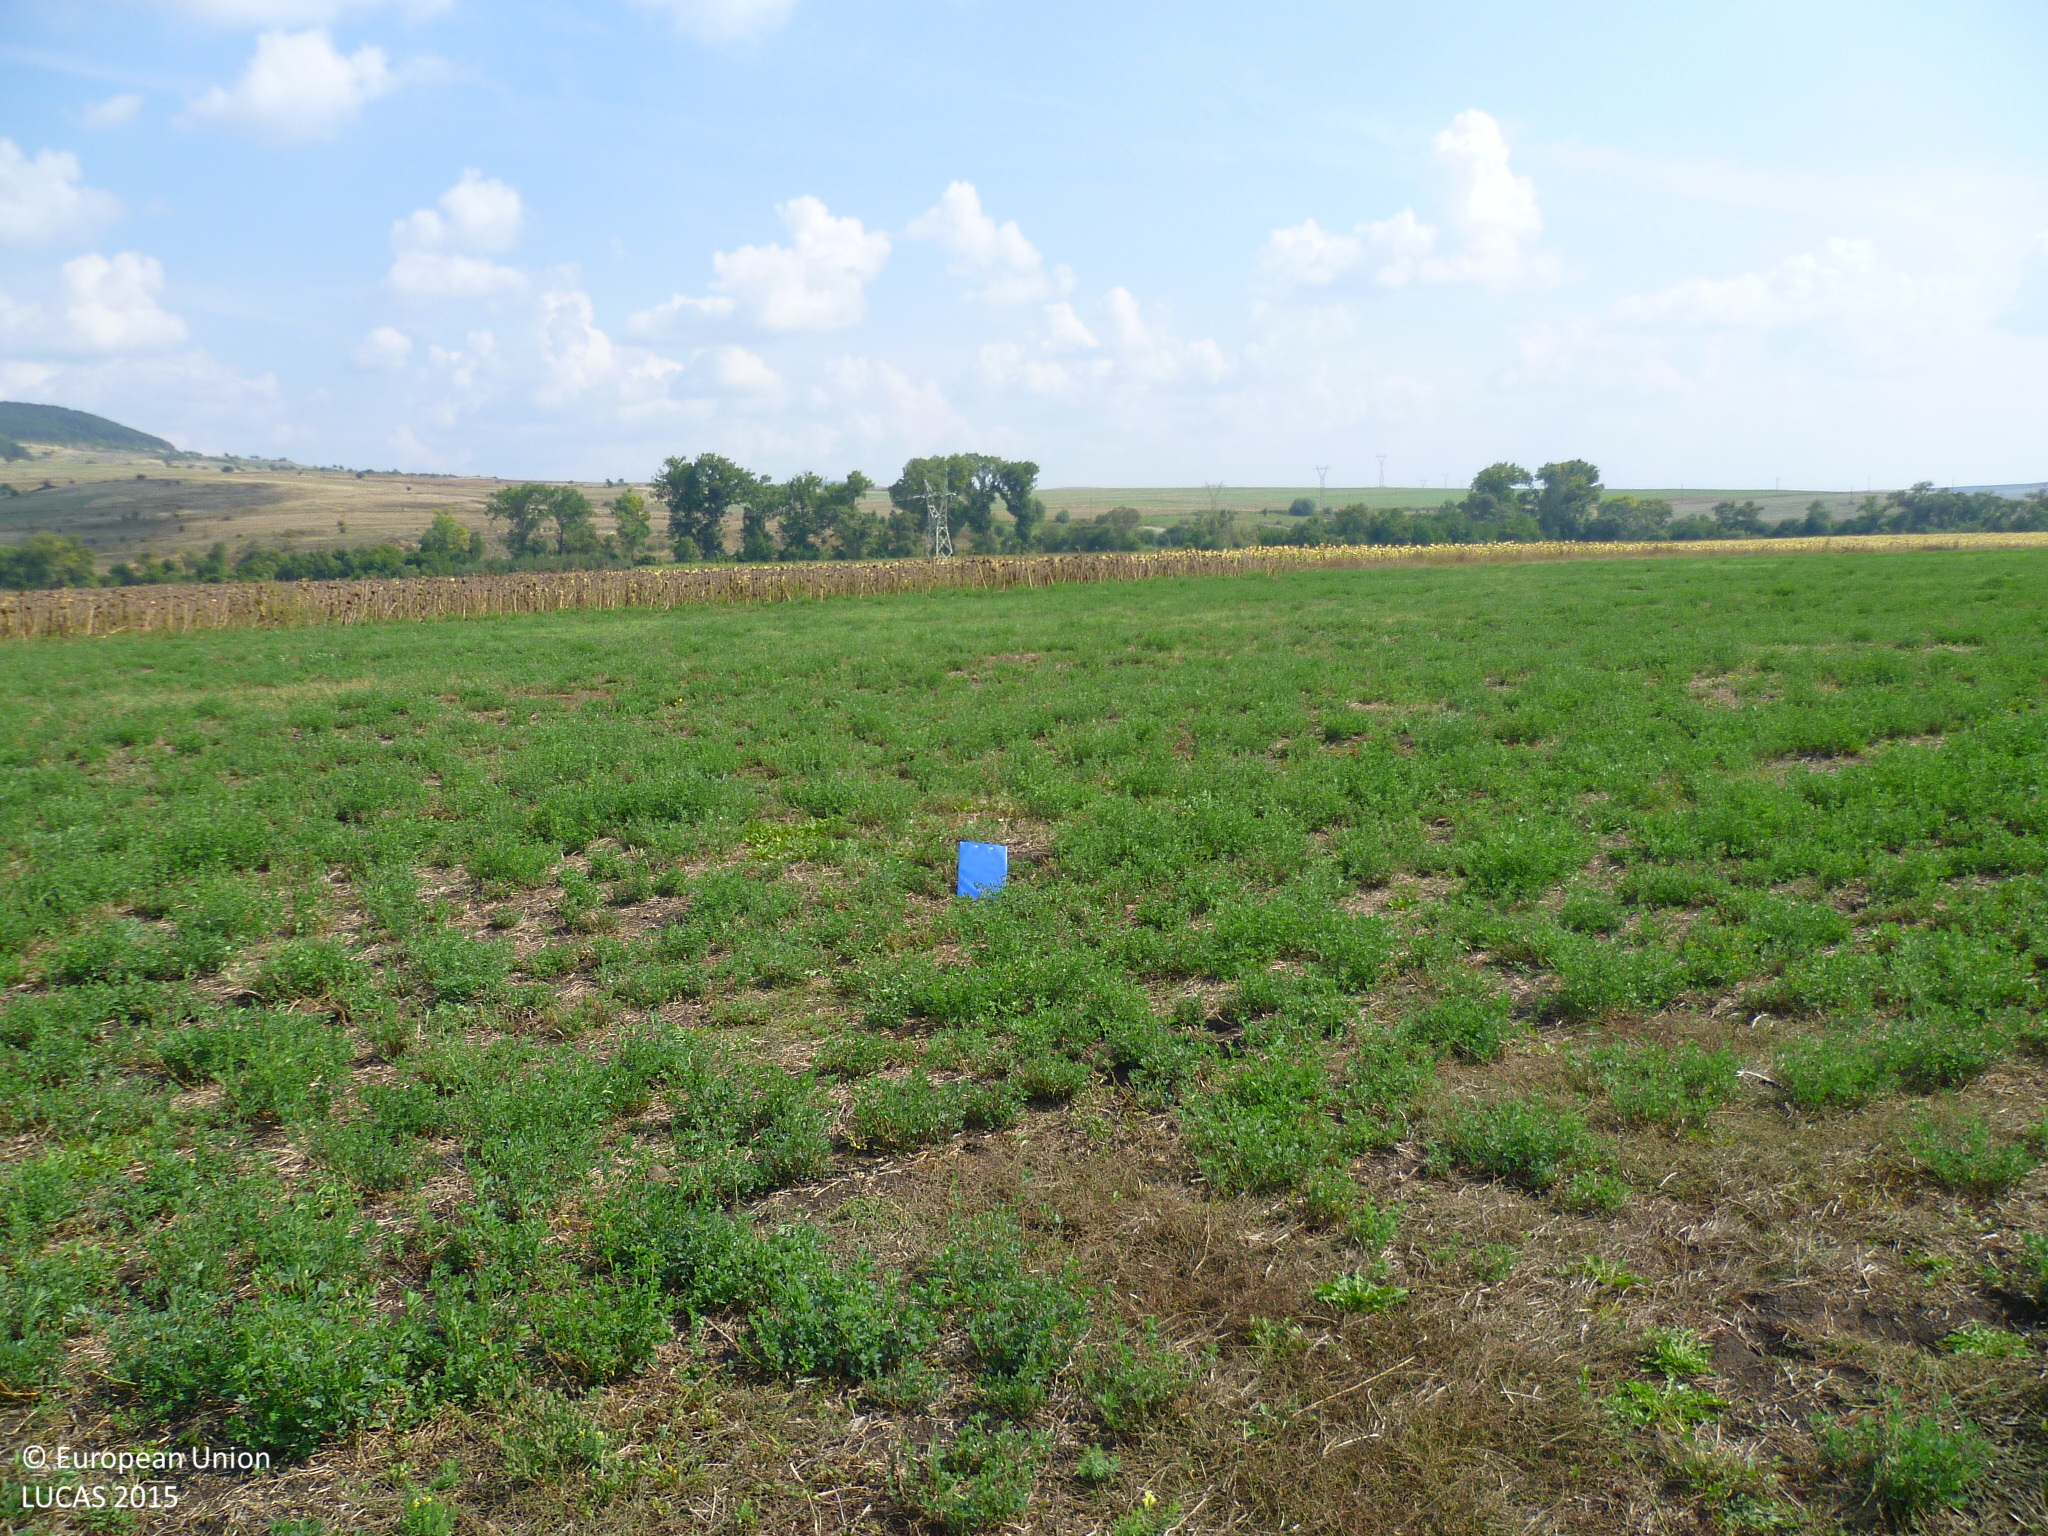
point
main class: Cropland
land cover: Lucerne
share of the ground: 50 - 75 %
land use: Agriculture (excluding fallow land and kitchen gardens)
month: September
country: BG
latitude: 42.7218
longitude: 22.8875
